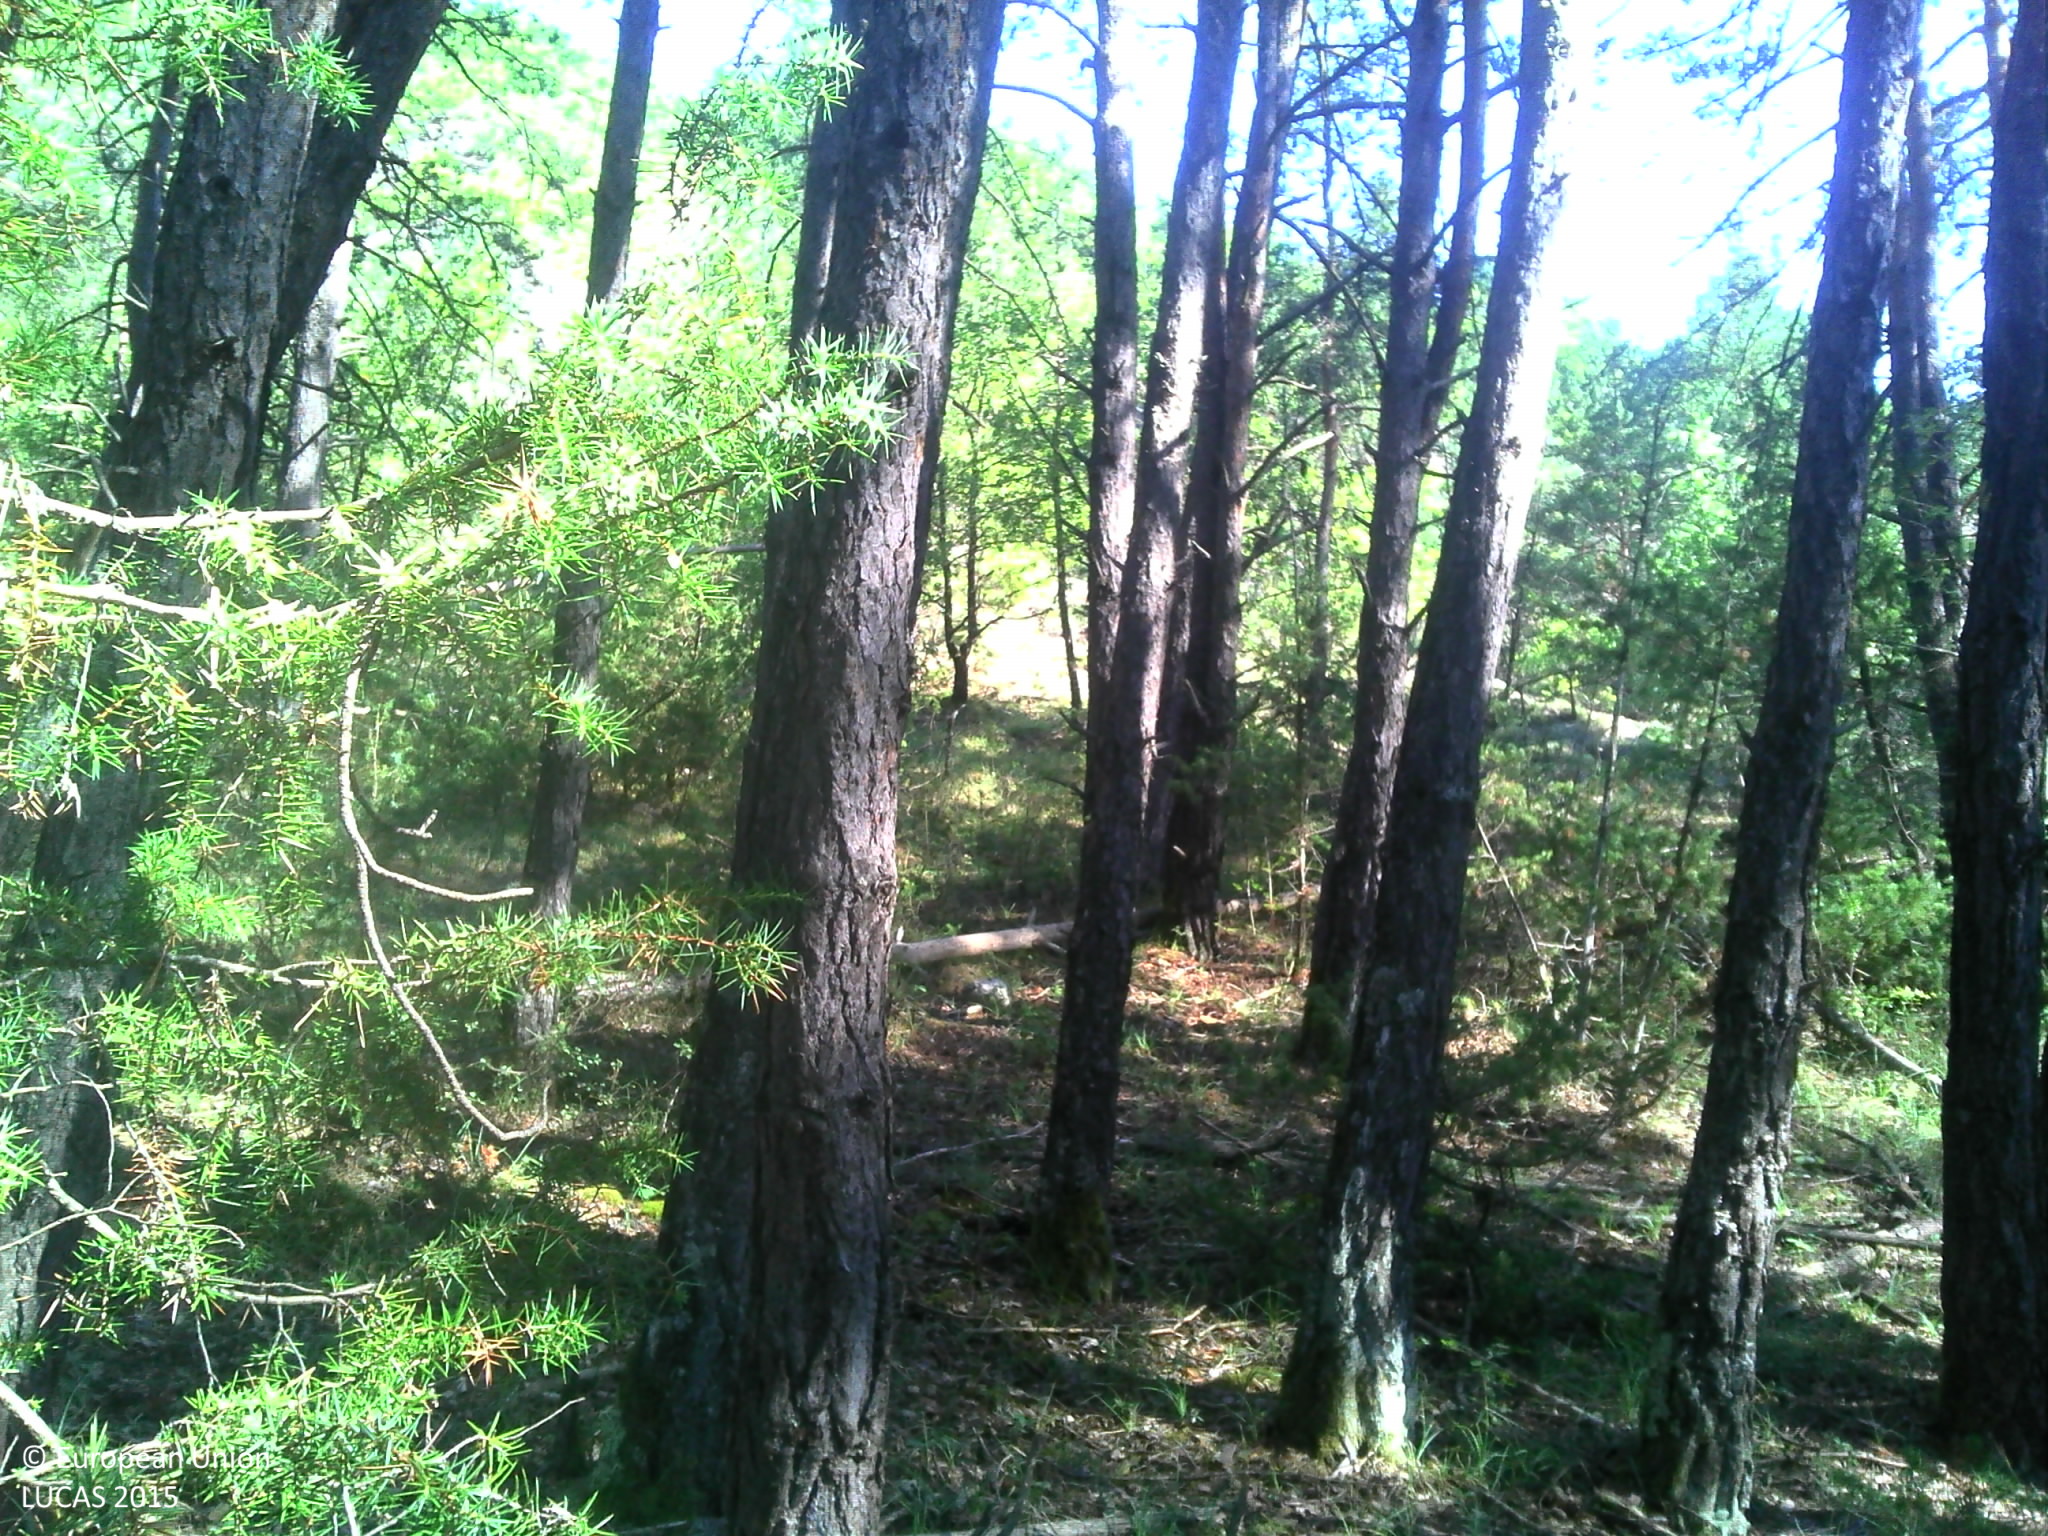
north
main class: Woodland
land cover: Pine dominated mixed woodland
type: alpine coniferous forest
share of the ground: > 75 %
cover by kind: coniferous forest trees 40 %, broadleaved forest trees 20 %, shrubs 20 %, herbaceous plants 20 %
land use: Forestry
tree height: > 5 m
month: August
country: FR
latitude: 44.1391
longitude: 6.2698
